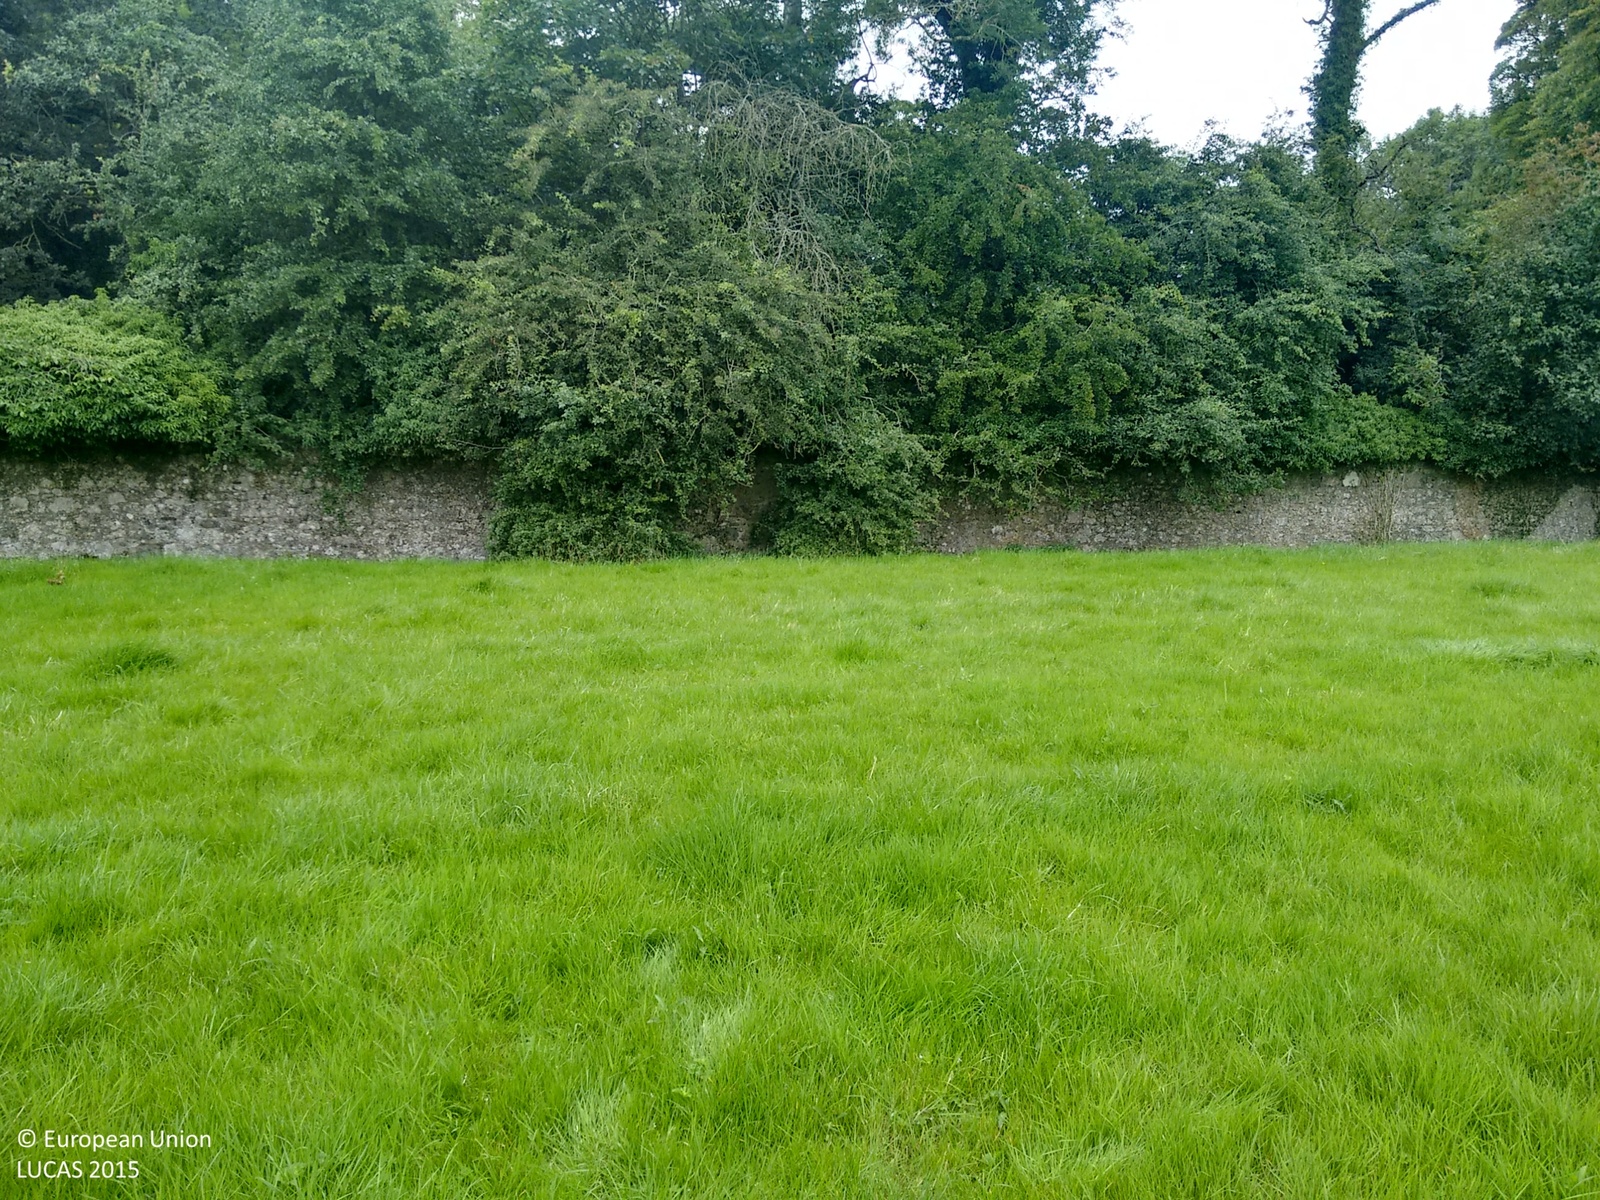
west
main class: Grassland
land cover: Grassland without tree/shrub cover
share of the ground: > 75 %
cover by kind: herbaceous plants 100 %
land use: Agriculture (excluding fallow land and kitchen gardens)
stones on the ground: < 10 %
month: August
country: IE
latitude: 53.9723
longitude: -6.7351
